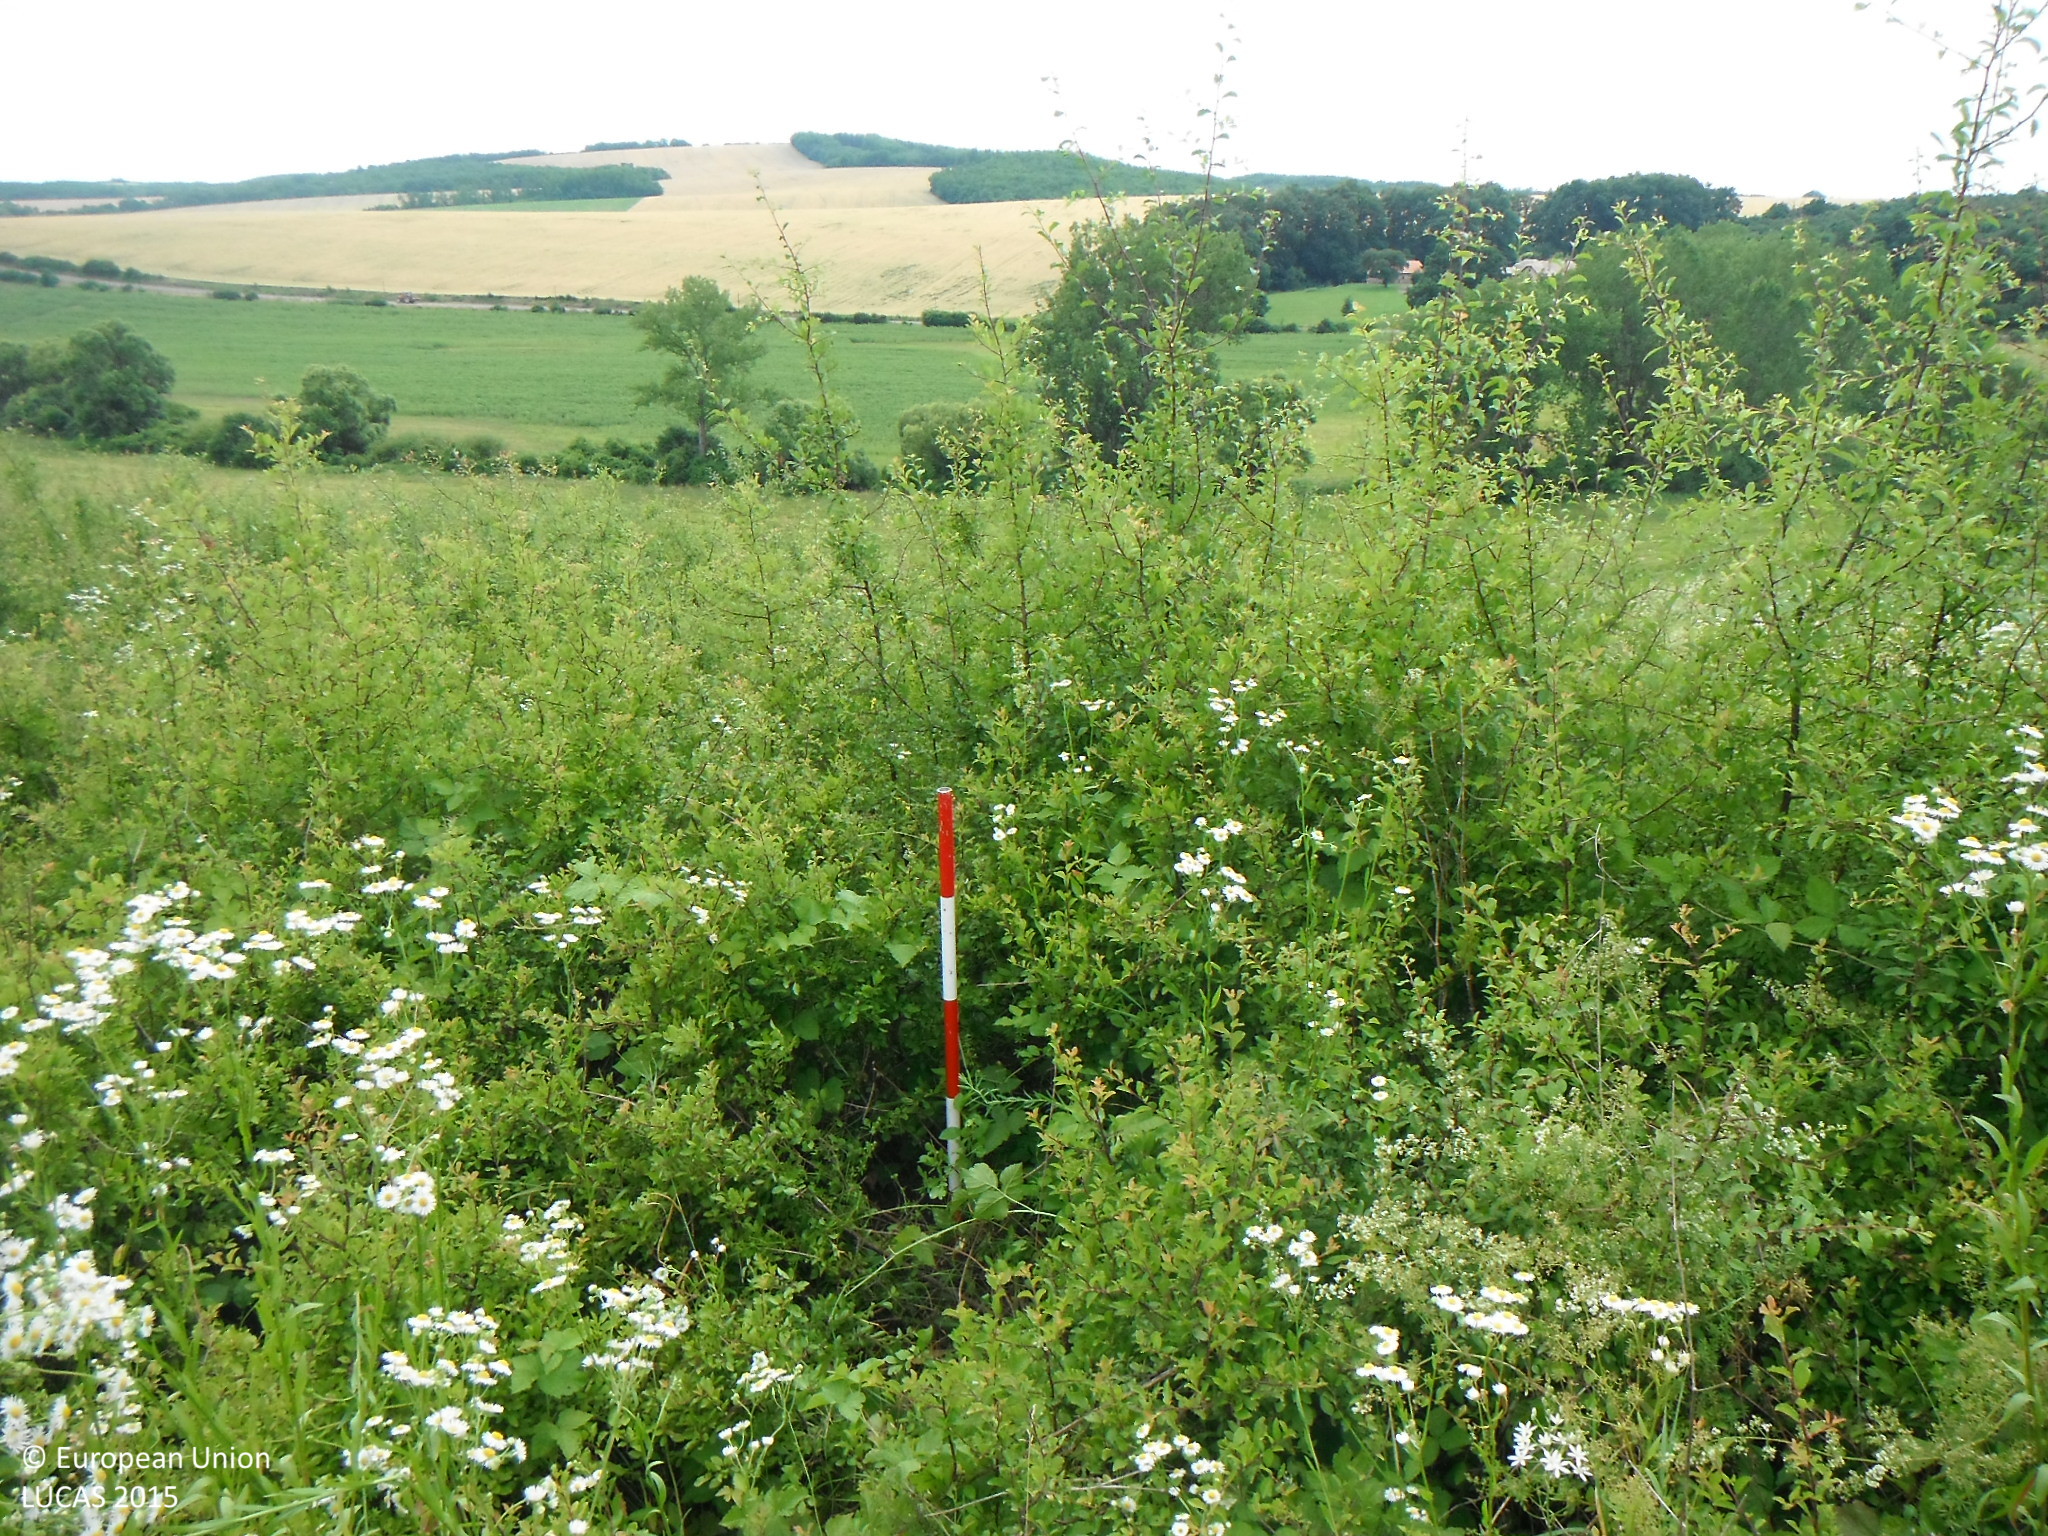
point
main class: Shrubland
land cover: Shrubland without tree cover
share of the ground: > 75 %
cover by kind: shrubs 90 %, herbaceous plants 10 %
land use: Semi-natural and natural areas not in use
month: June
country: SK
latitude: 48.1410
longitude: 19.4713
